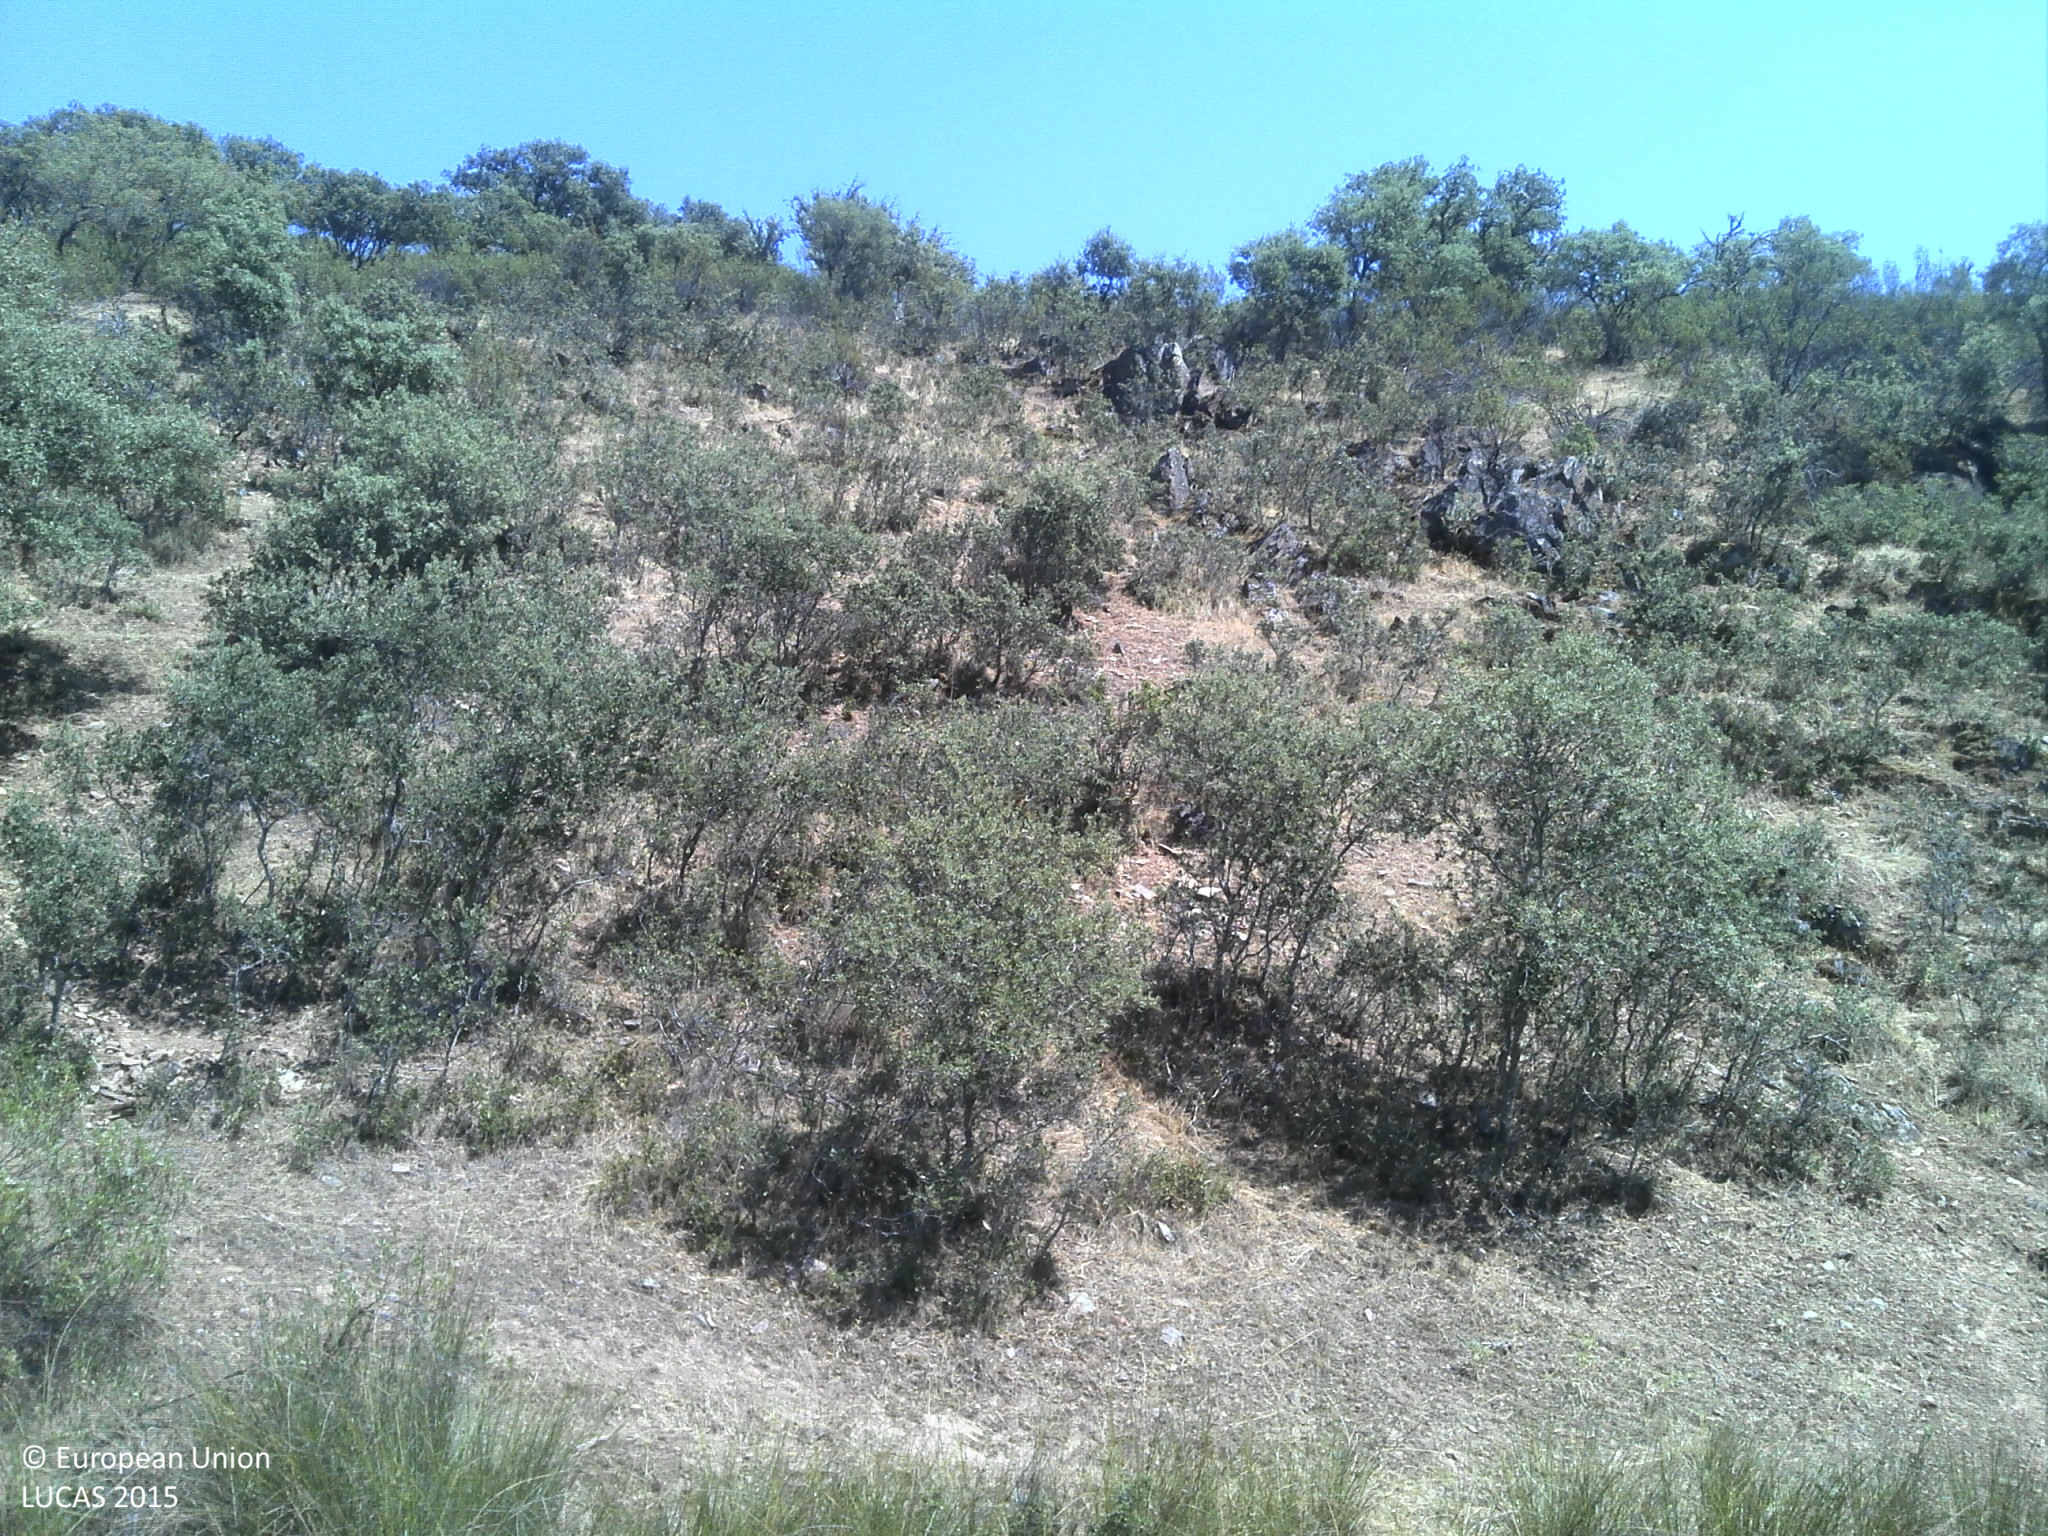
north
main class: Shrubland
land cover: Shrubland with sparse tree cover
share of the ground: 50 - 75 %
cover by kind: shrubs 55 %, herbaceous plants 25 %, unconsolidated bare surface 10 %, broadleaved forest trees 5 %
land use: Forestry
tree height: > 5 m
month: June
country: PT
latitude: 39.6722
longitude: -7.1195
